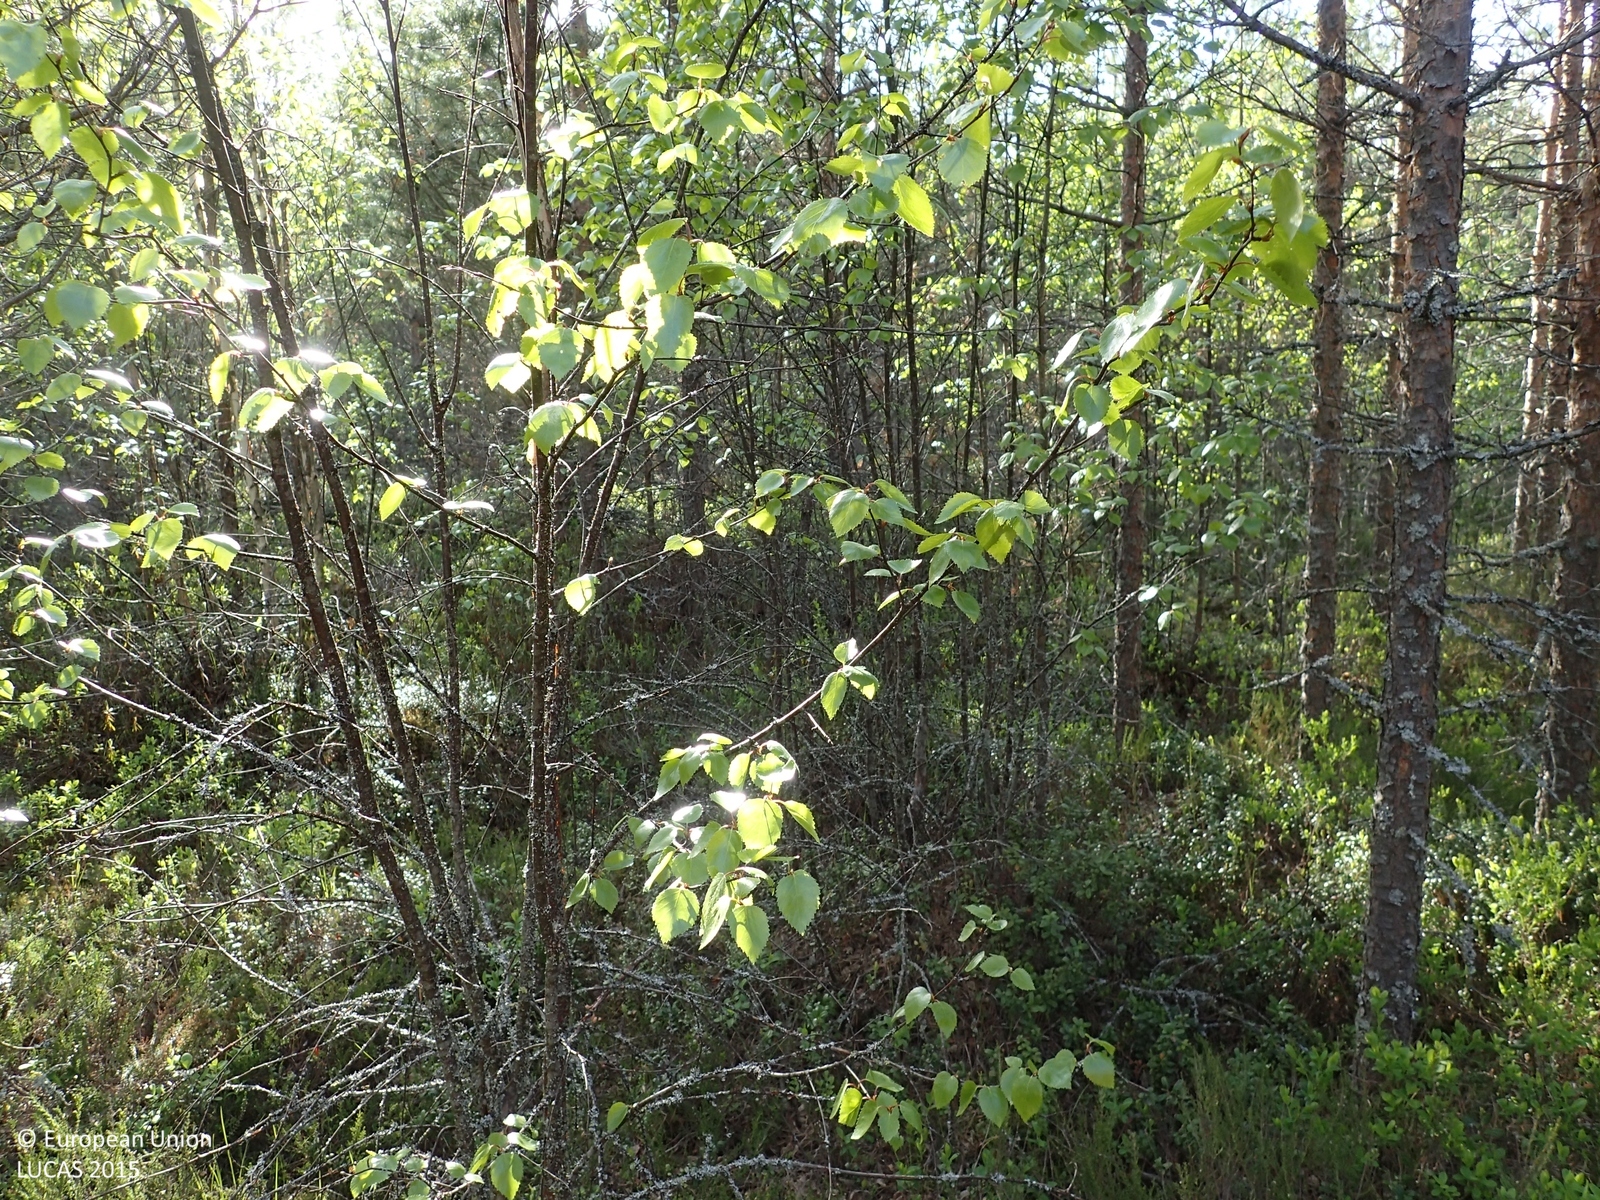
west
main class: Woodland
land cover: Pine dominated coniferous woodland
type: boreal forest
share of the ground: > 75 %
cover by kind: coniferous forest trees 80 %, shrubs 15 %, broadleaved forest trees 5 %
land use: Forestry
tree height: < 5 m
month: June
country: FI
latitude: 62.3763
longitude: 22.5658
